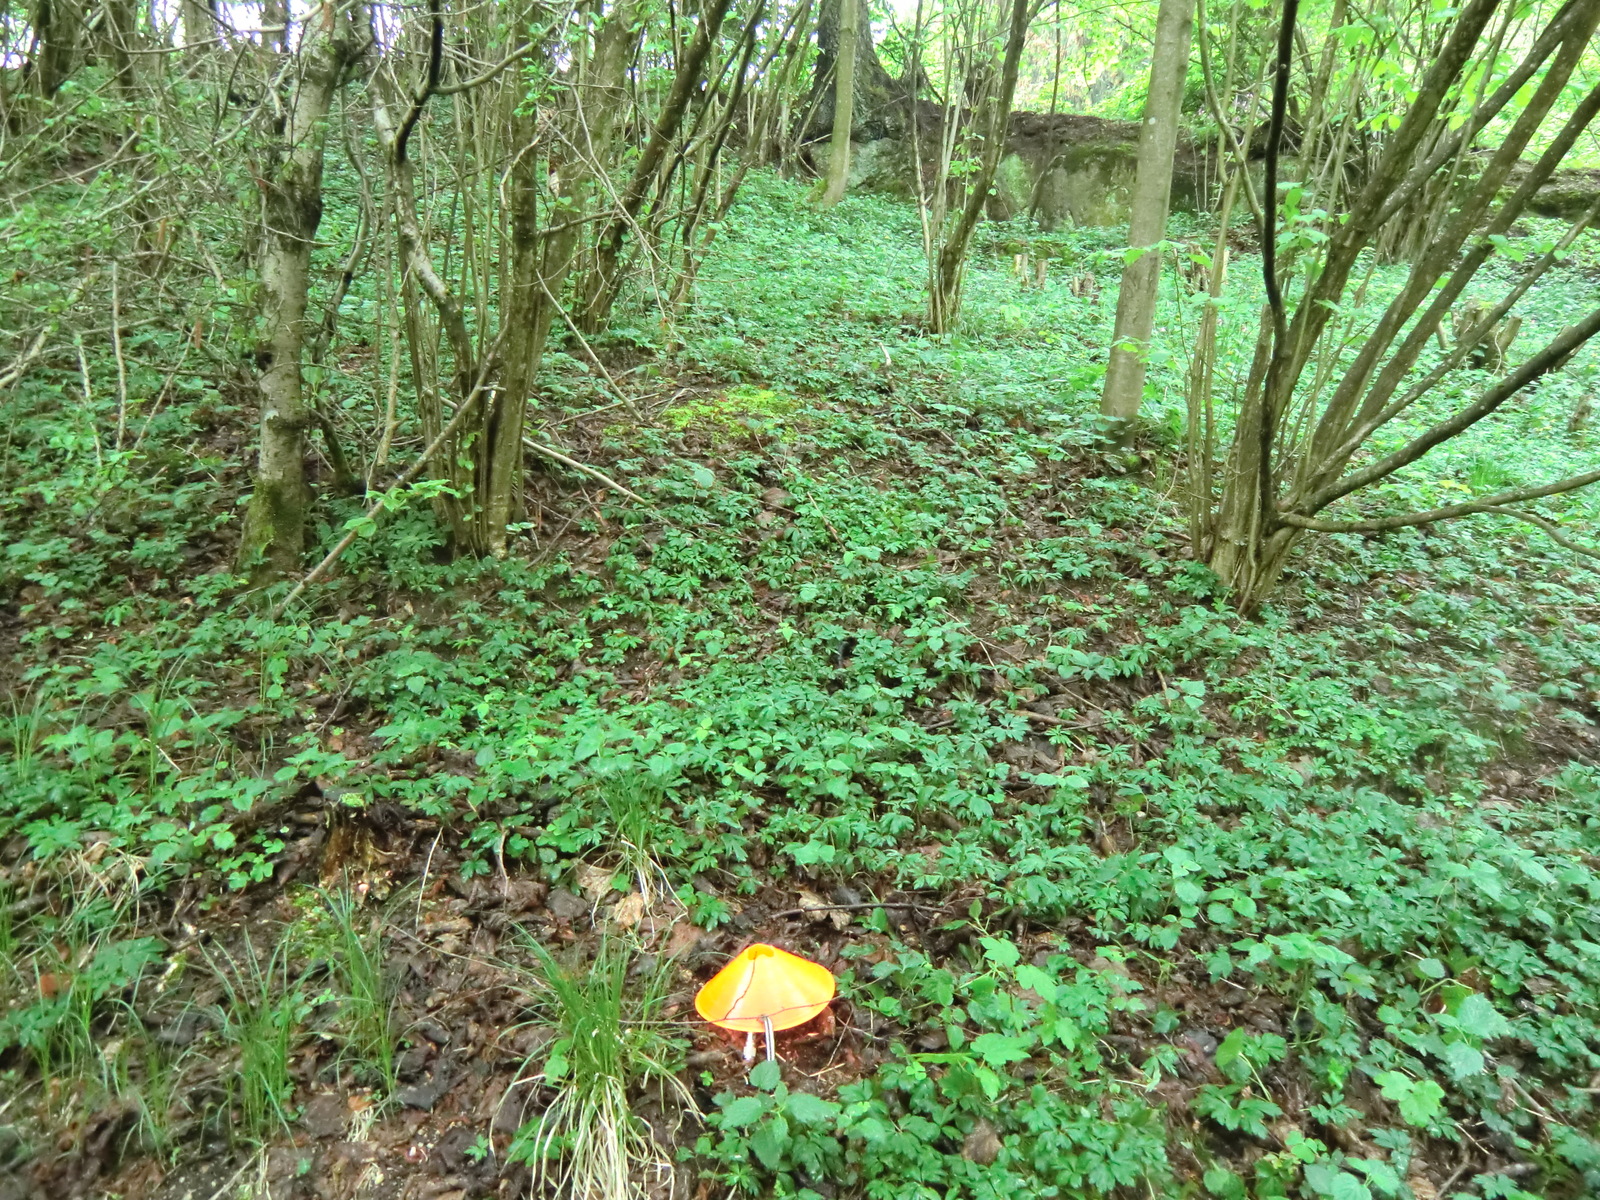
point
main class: Woodland
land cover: Broadleaved woodland
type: hemiboreal forest and nemoral coniferous forest and mixed broadleaved-coniferous forest
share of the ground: > 75 %
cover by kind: broadleaved forest trees 55 %, herbaceous plants 30 %, unconsolidated bare surface 10 %, coniferous forest trees 5 %
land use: Forestry
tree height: > 5 m
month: May
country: AT
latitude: 48.3213
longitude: 14.7075
